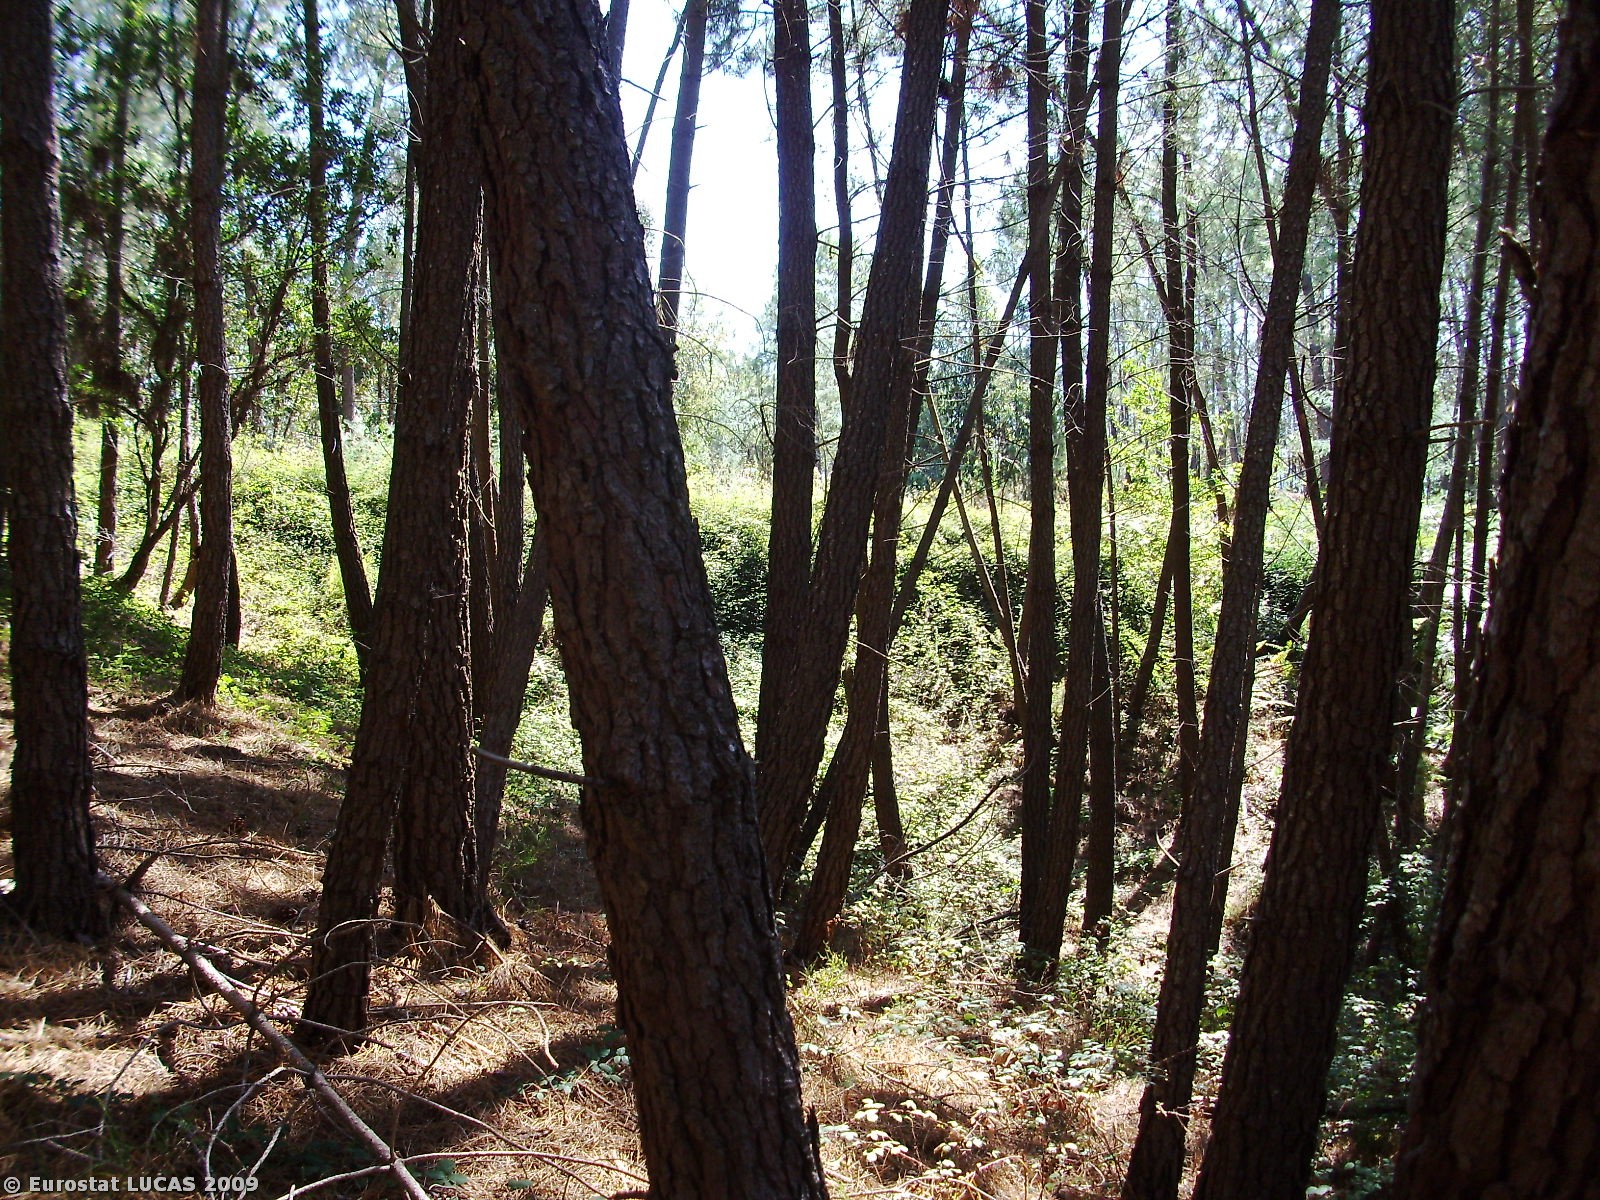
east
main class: Woodland
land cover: Coniferous woodland
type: coniferous forest of the mediterranean region
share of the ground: > 75 %
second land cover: Shrubland with sparse tree cover
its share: 10 - 25 %
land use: Forestry
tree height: > 5 m
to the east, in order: Coniferous woodland; Shrubland with sparse tree cover; Coniferous woodland; Paved roads, cycling and walking lanes; Tracks; Broadleaved woodland; Shrubland with sparse tree cover; Tracks; Broadleaved woodland; Tracks; Broadleaved woodland
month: August
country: PT
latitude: 39.9967
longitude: -8.1688
